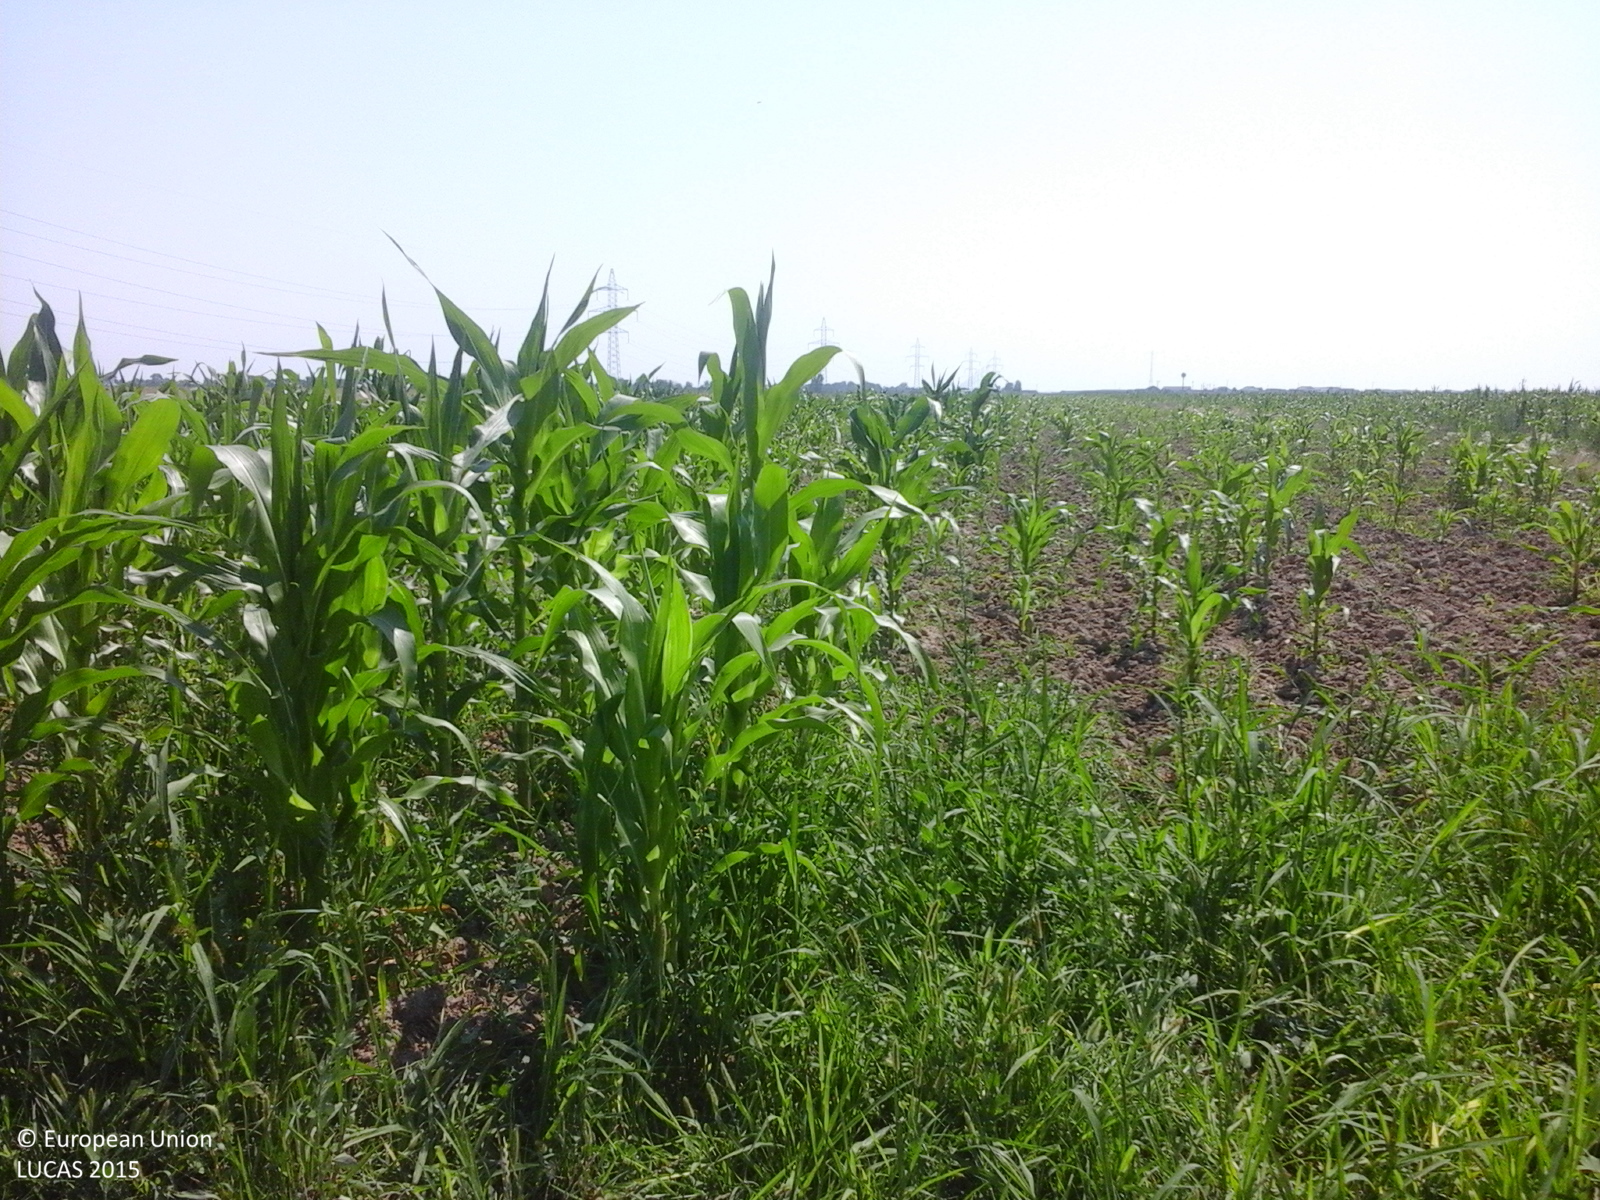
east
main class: Cropland
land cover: Maize
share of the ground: 50 - 75 %
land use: Agriculture (excluding fallow land and kitchen gardens)
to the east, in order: Tracks; Grass margins; Maize; Common wheat; Grass margins; Maize; Common wheat
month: July
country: RO
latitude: 44.7334
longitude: 25.0219
